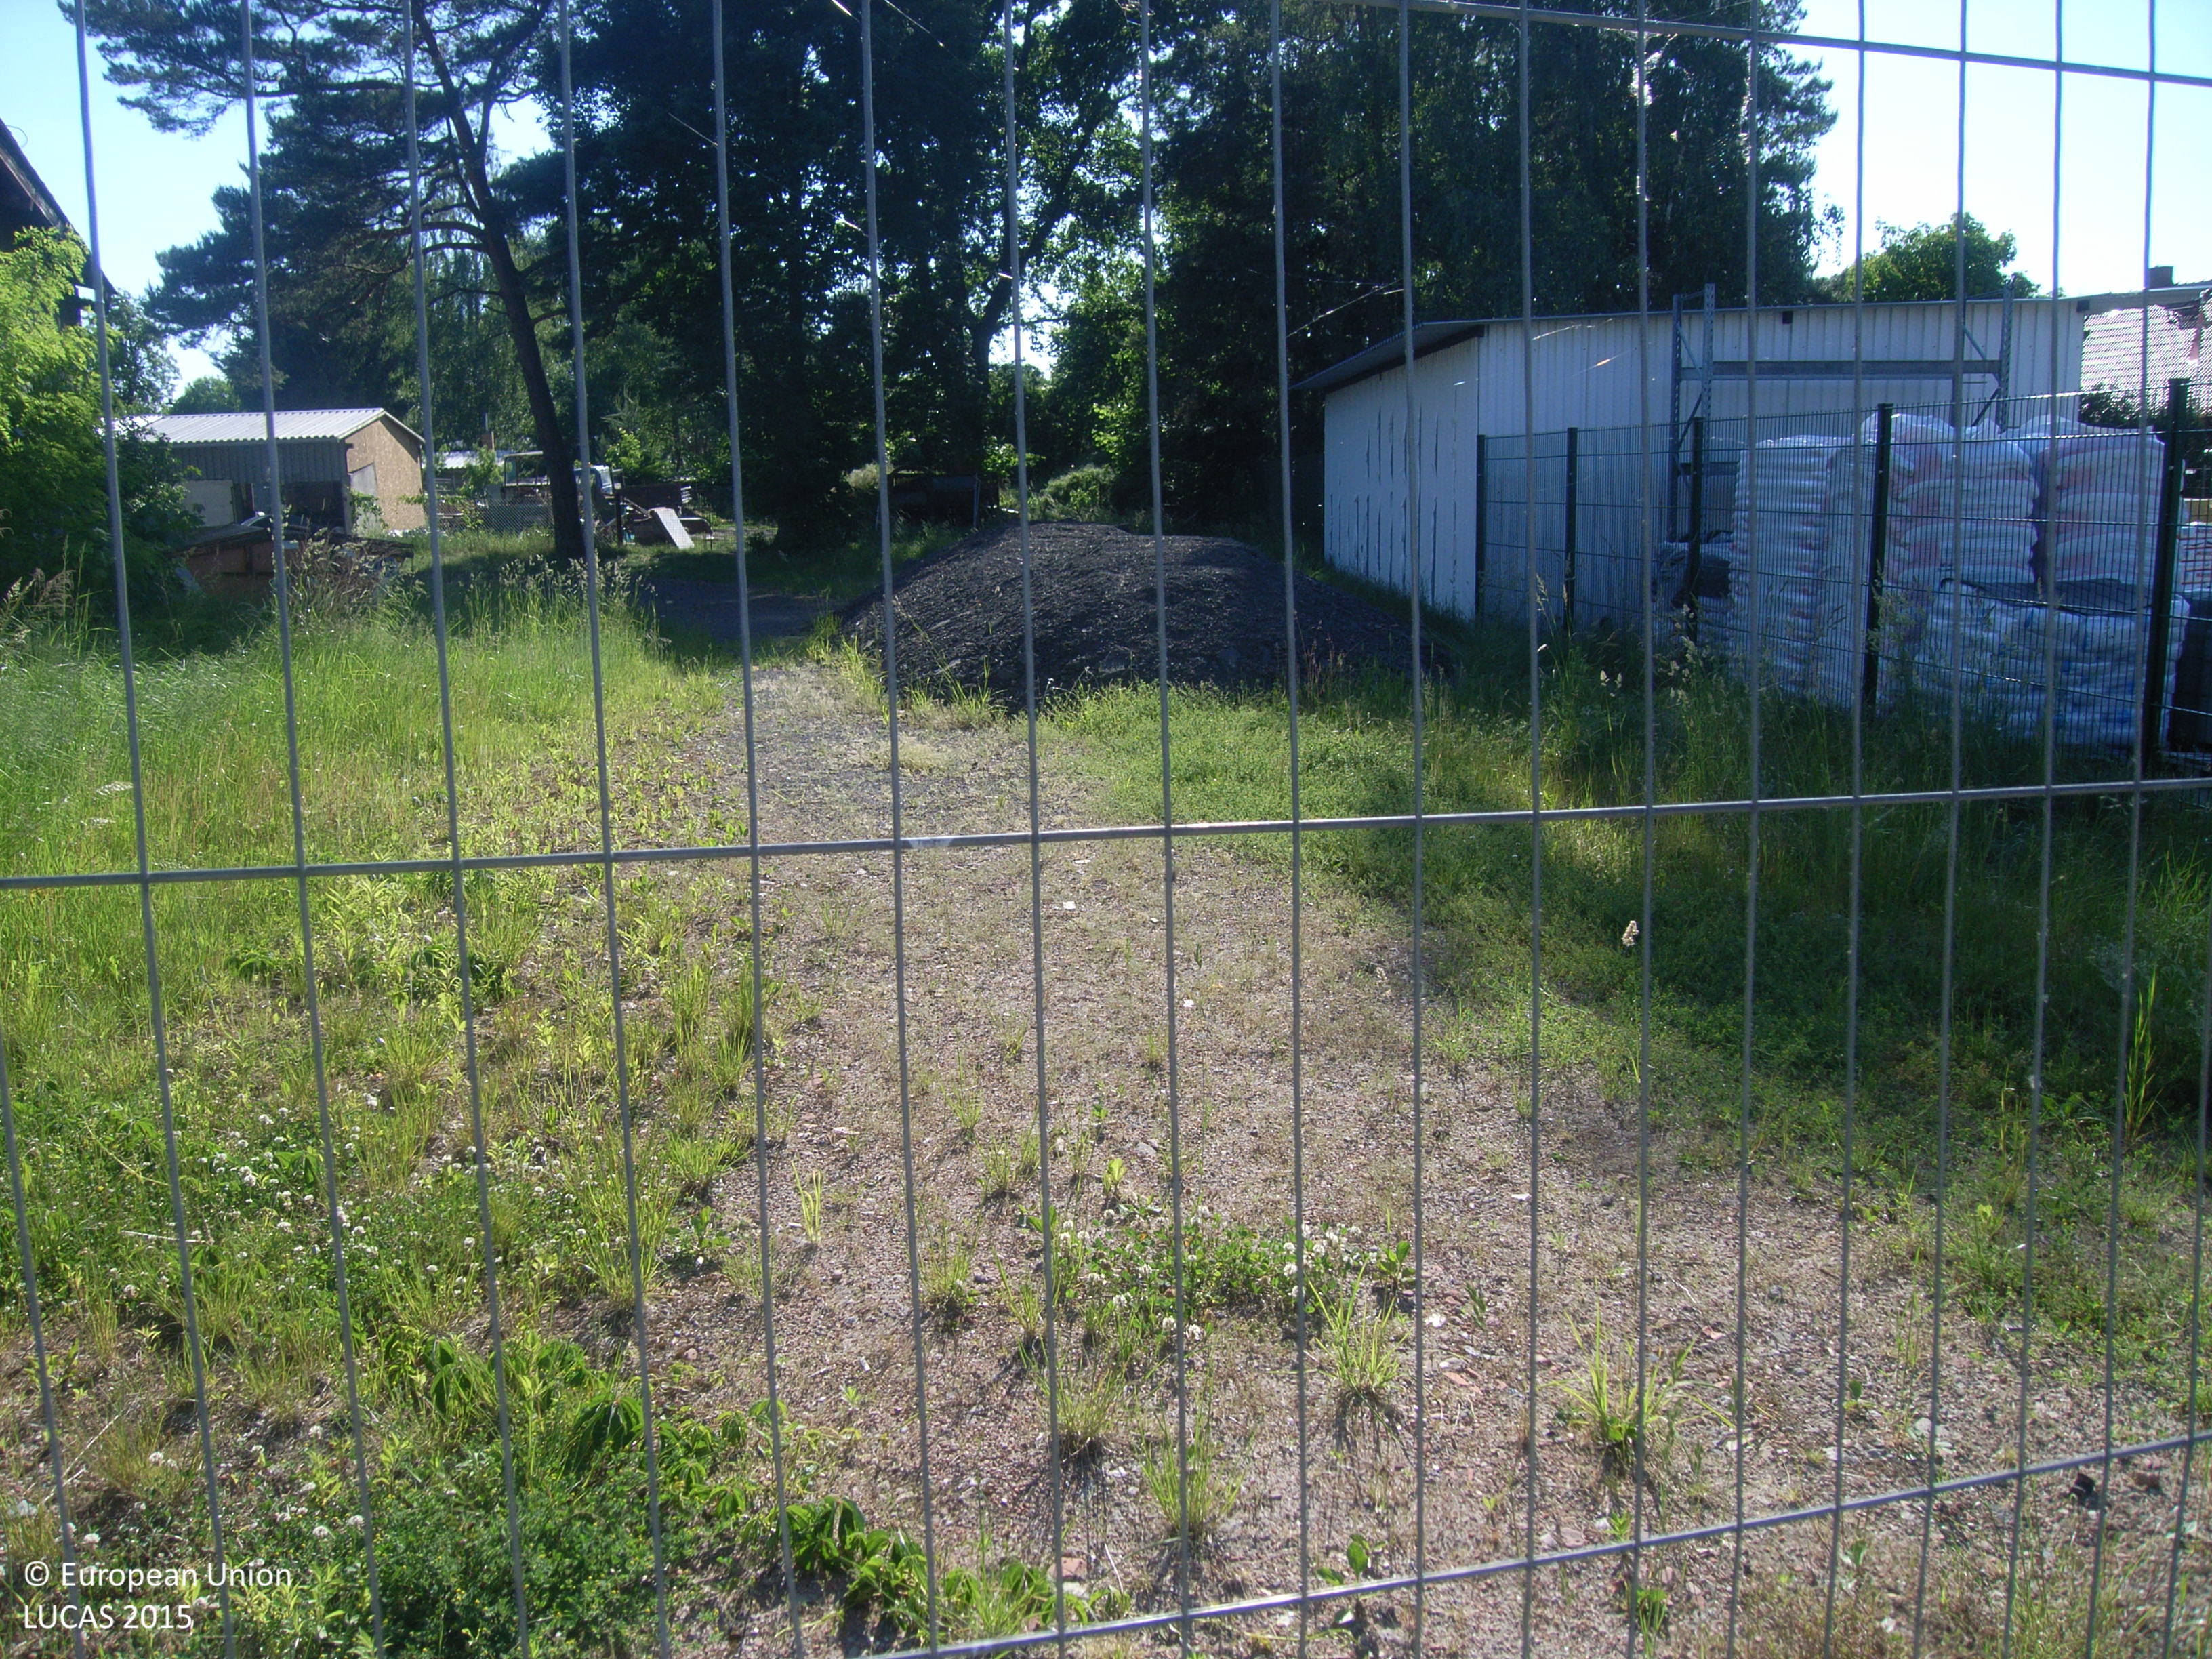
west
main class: Grassland
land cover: Grassland without tree/shrub cover
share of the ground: > 75 %
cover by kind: herbaceous plants 100 %
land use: Construction
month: June
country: DE
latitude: 52.2416
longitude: 14.4096
